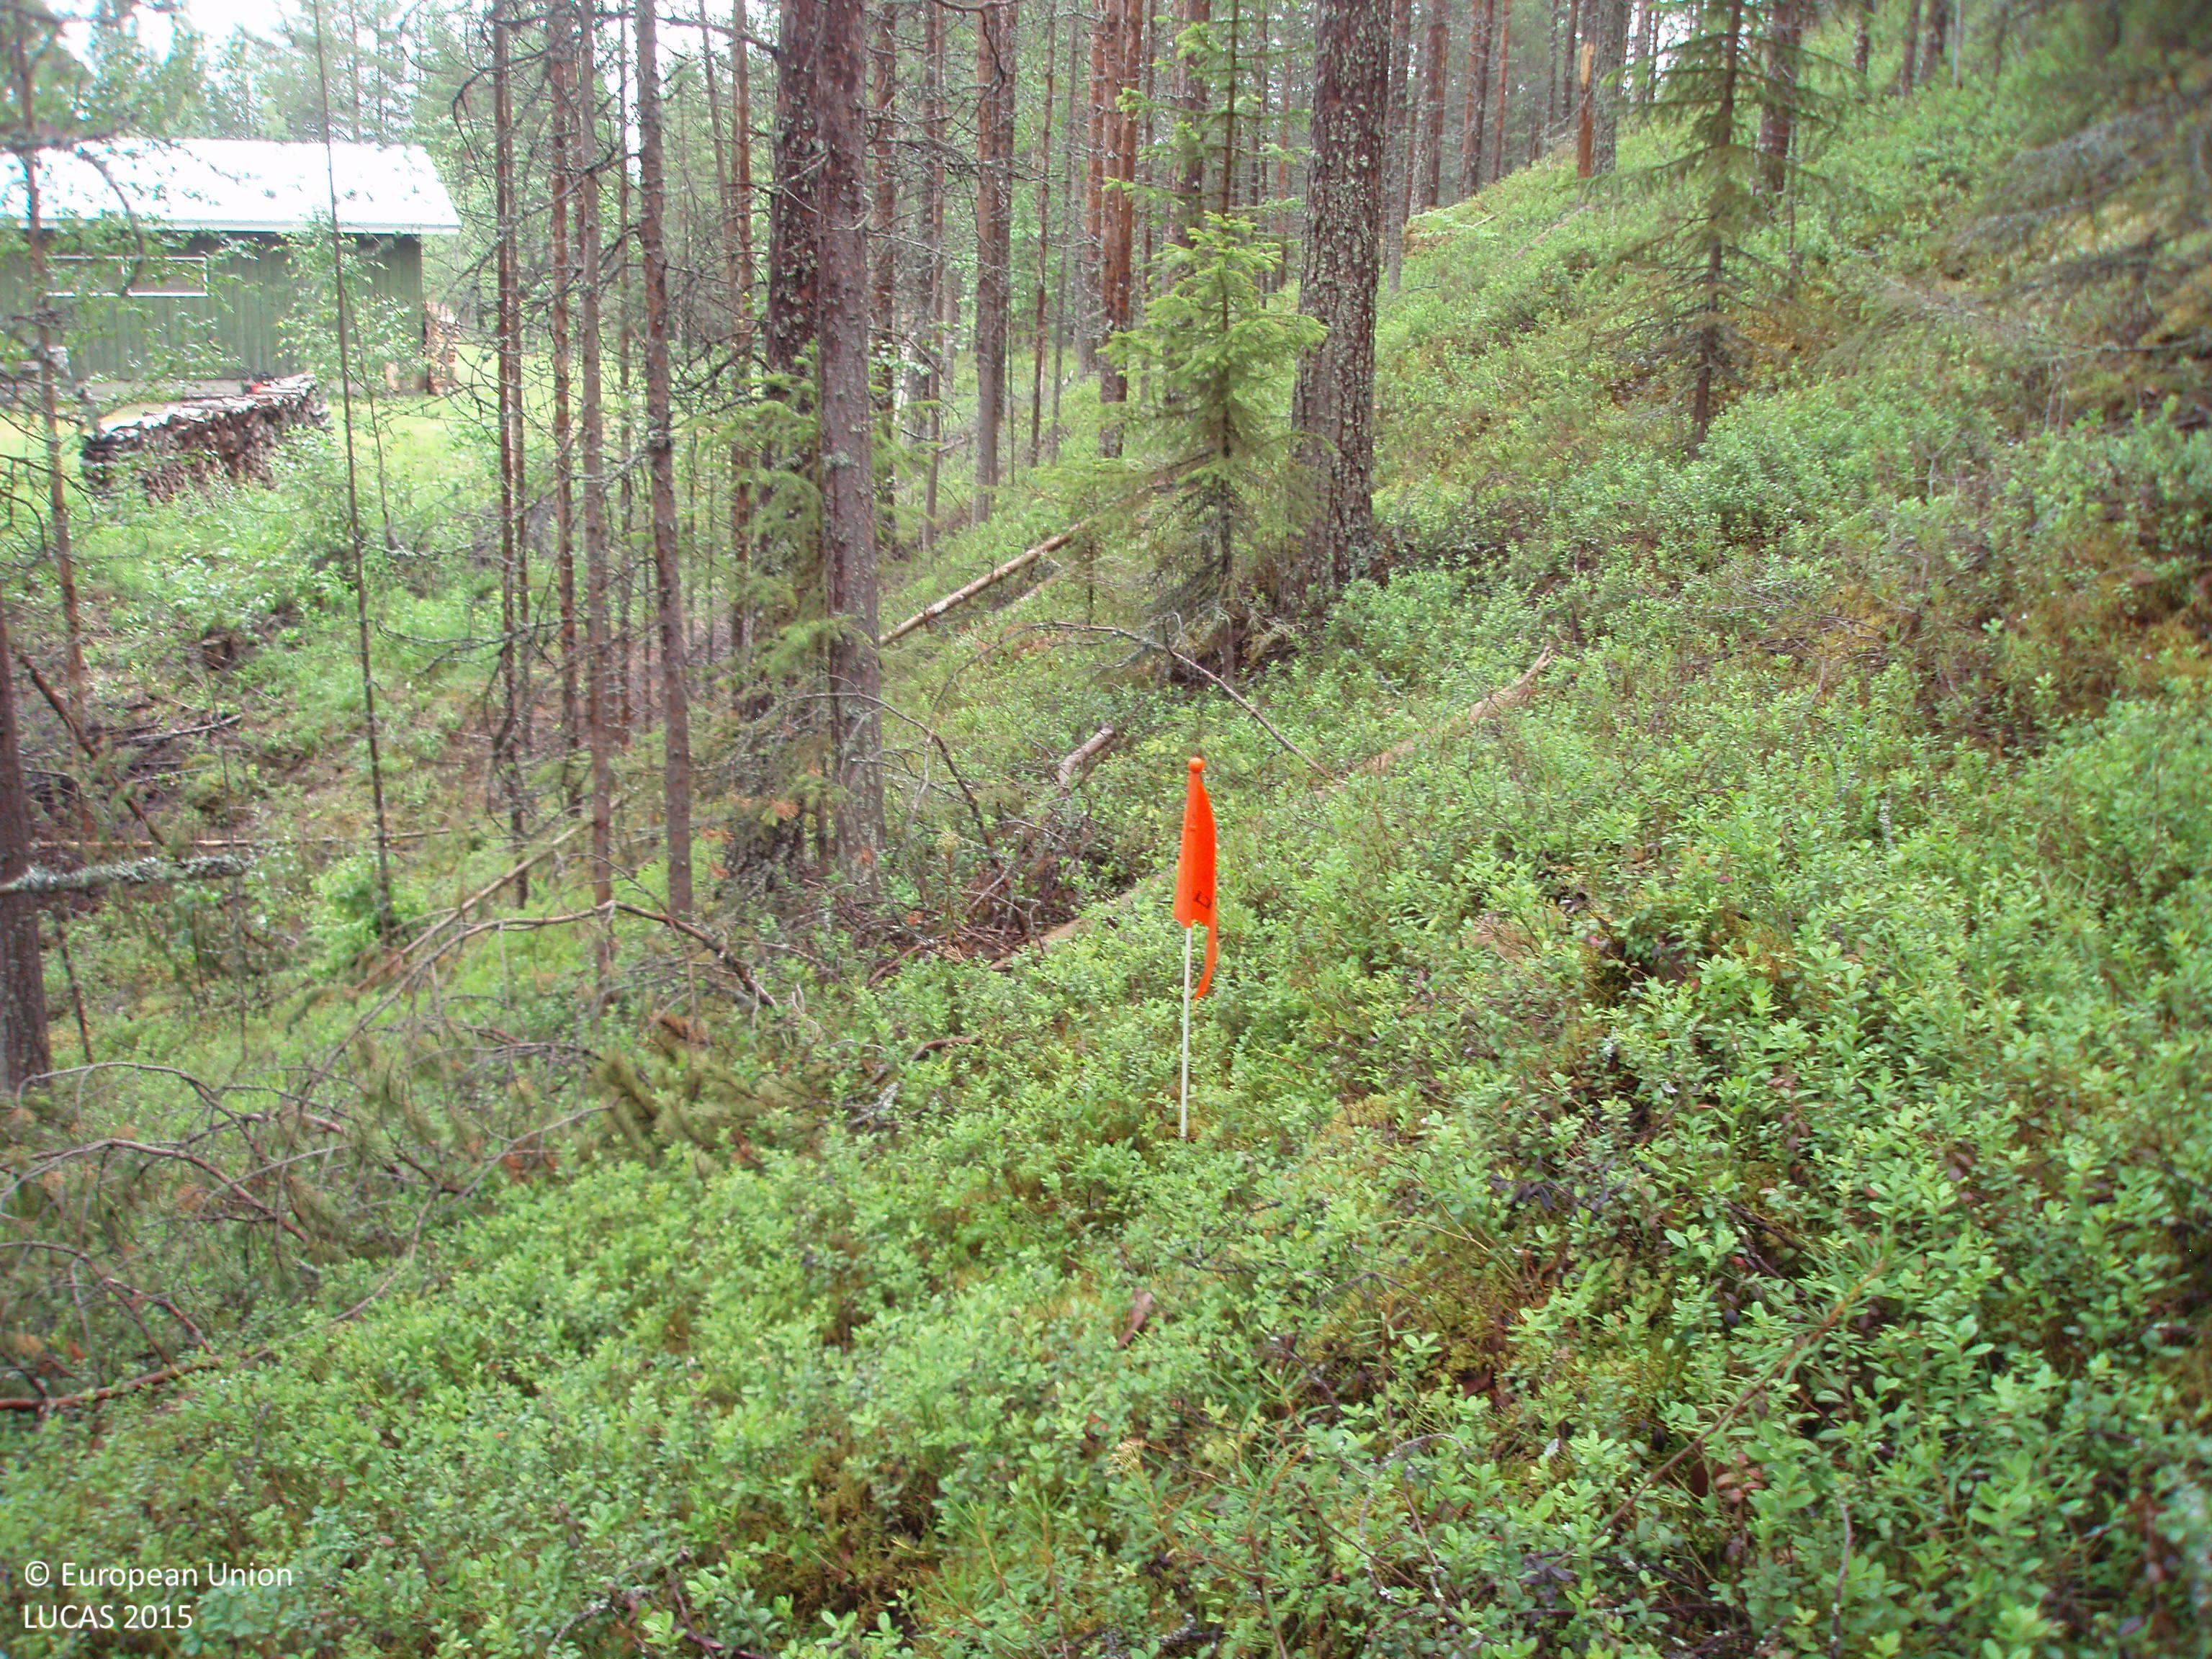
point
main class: Woodland
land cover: Pine dominated coniferous woodland
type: boreal forest
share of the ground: 50 - 75 %
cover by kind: coniferous forest trees 70 %, shrubs 30 %
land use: Forestry
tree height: > 5 m
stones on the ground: 10 - 25 %
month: July
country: FI
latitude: 67.2351
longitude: 28.4020
